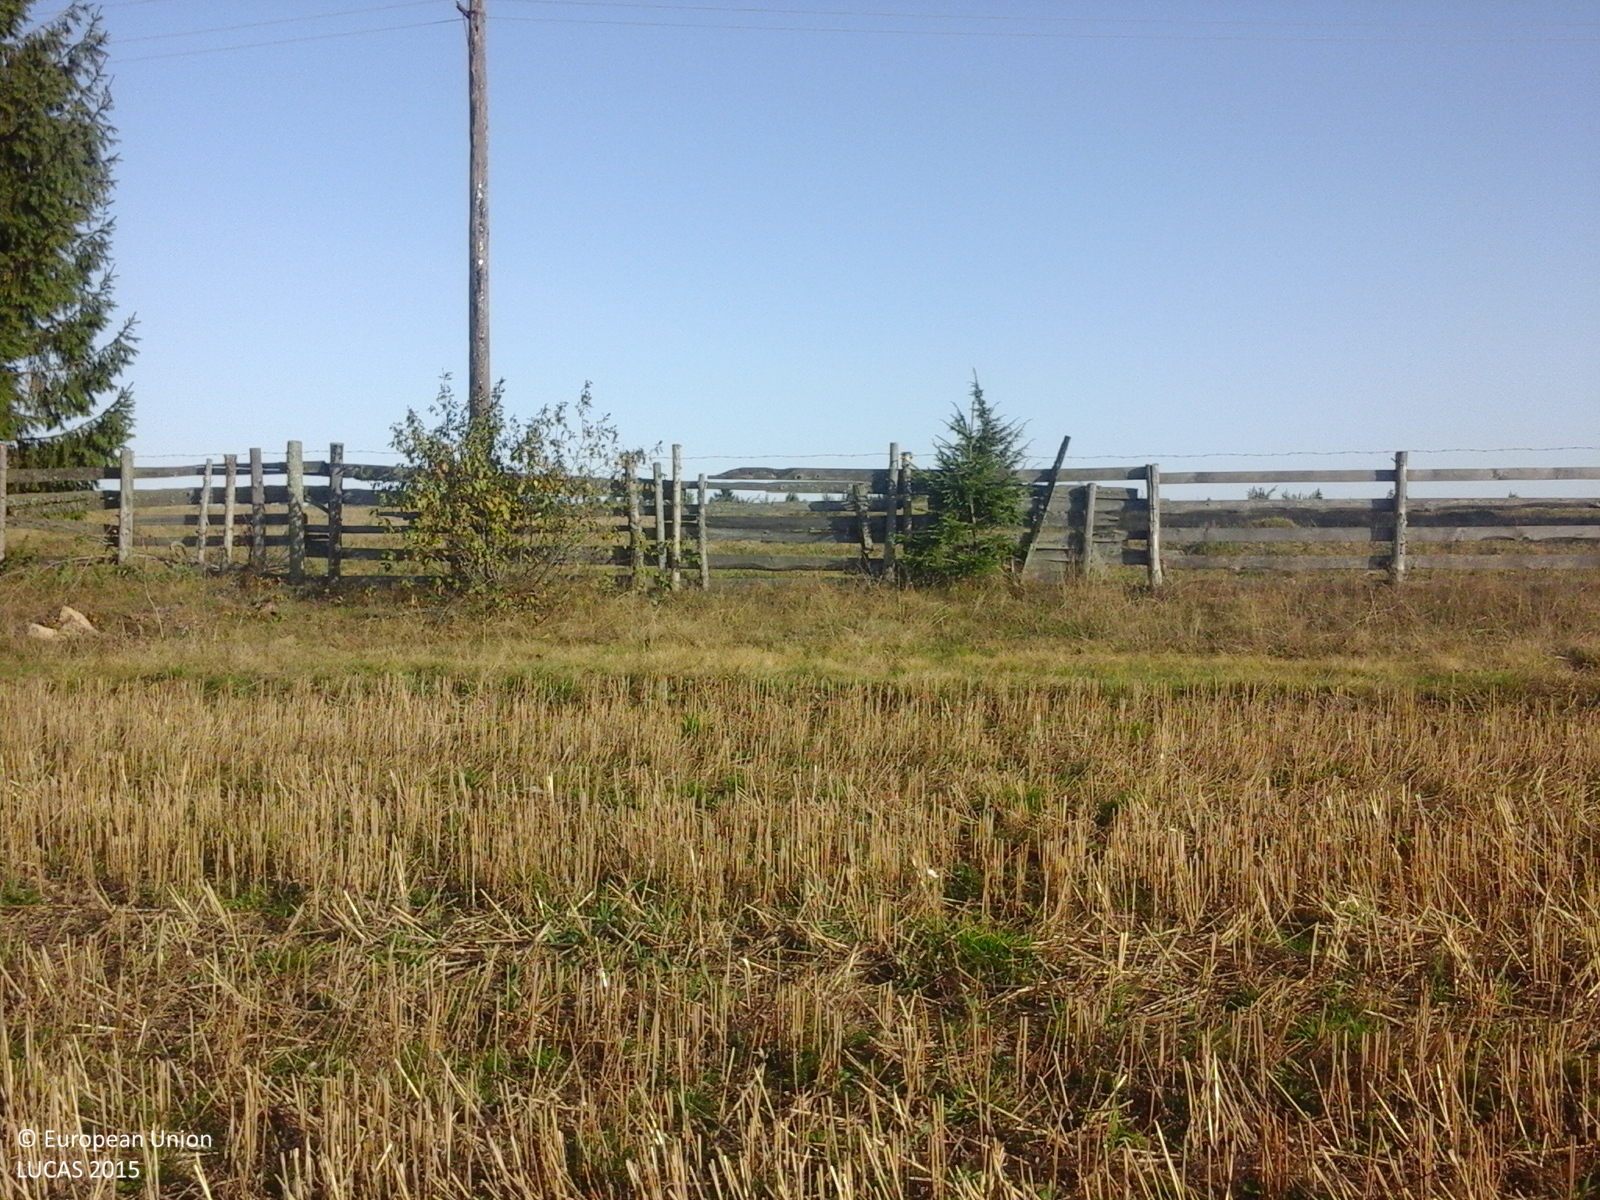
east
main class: Cropland
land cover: Barley
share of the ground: > 75 %
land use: Agriculture (excluding fallow land and kitchen gardens)
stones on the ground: < 10 %
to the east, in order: Barley; Spontaneously vegetated surfaces; Grassland without tree/shrub cover; Fences; Spontaneously vegetated surfaces; Electric lines; Spontaneously vegetated surfaces; Tracks; Grassland with sparse tree/shrub cover; Tracks; Spontaneously vegetated surfaces; Tracks; Spontaneously vegetated surfaces
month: October
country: RO
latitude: 46.5156
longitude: 25.2353
